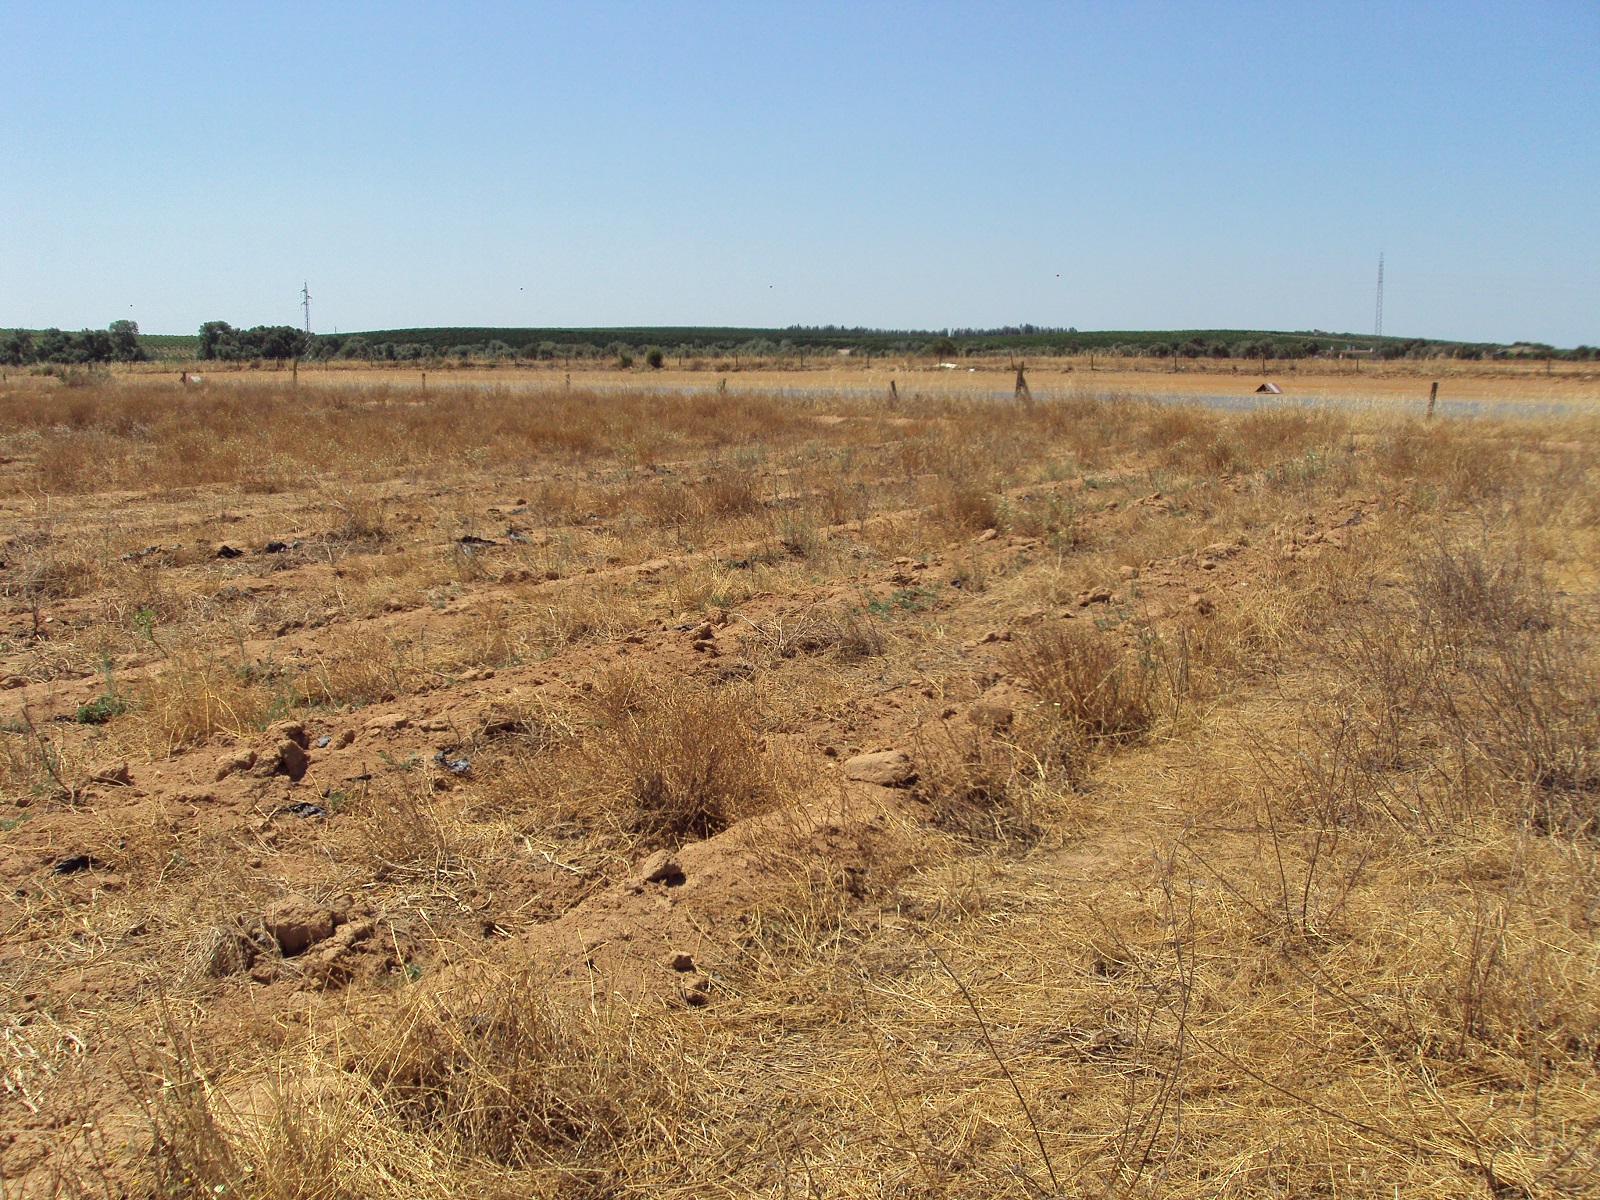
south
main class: Grassland
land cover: Grassland without tree/shrub cover
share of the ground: > 75 %
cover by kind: herbaceous plants 90 %, unconsolidated bare surface 10 %
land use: Agriculture (excluding fallow land and kitchen gardens)
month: June
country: ES
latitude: 37.3647
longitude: -6.9202
